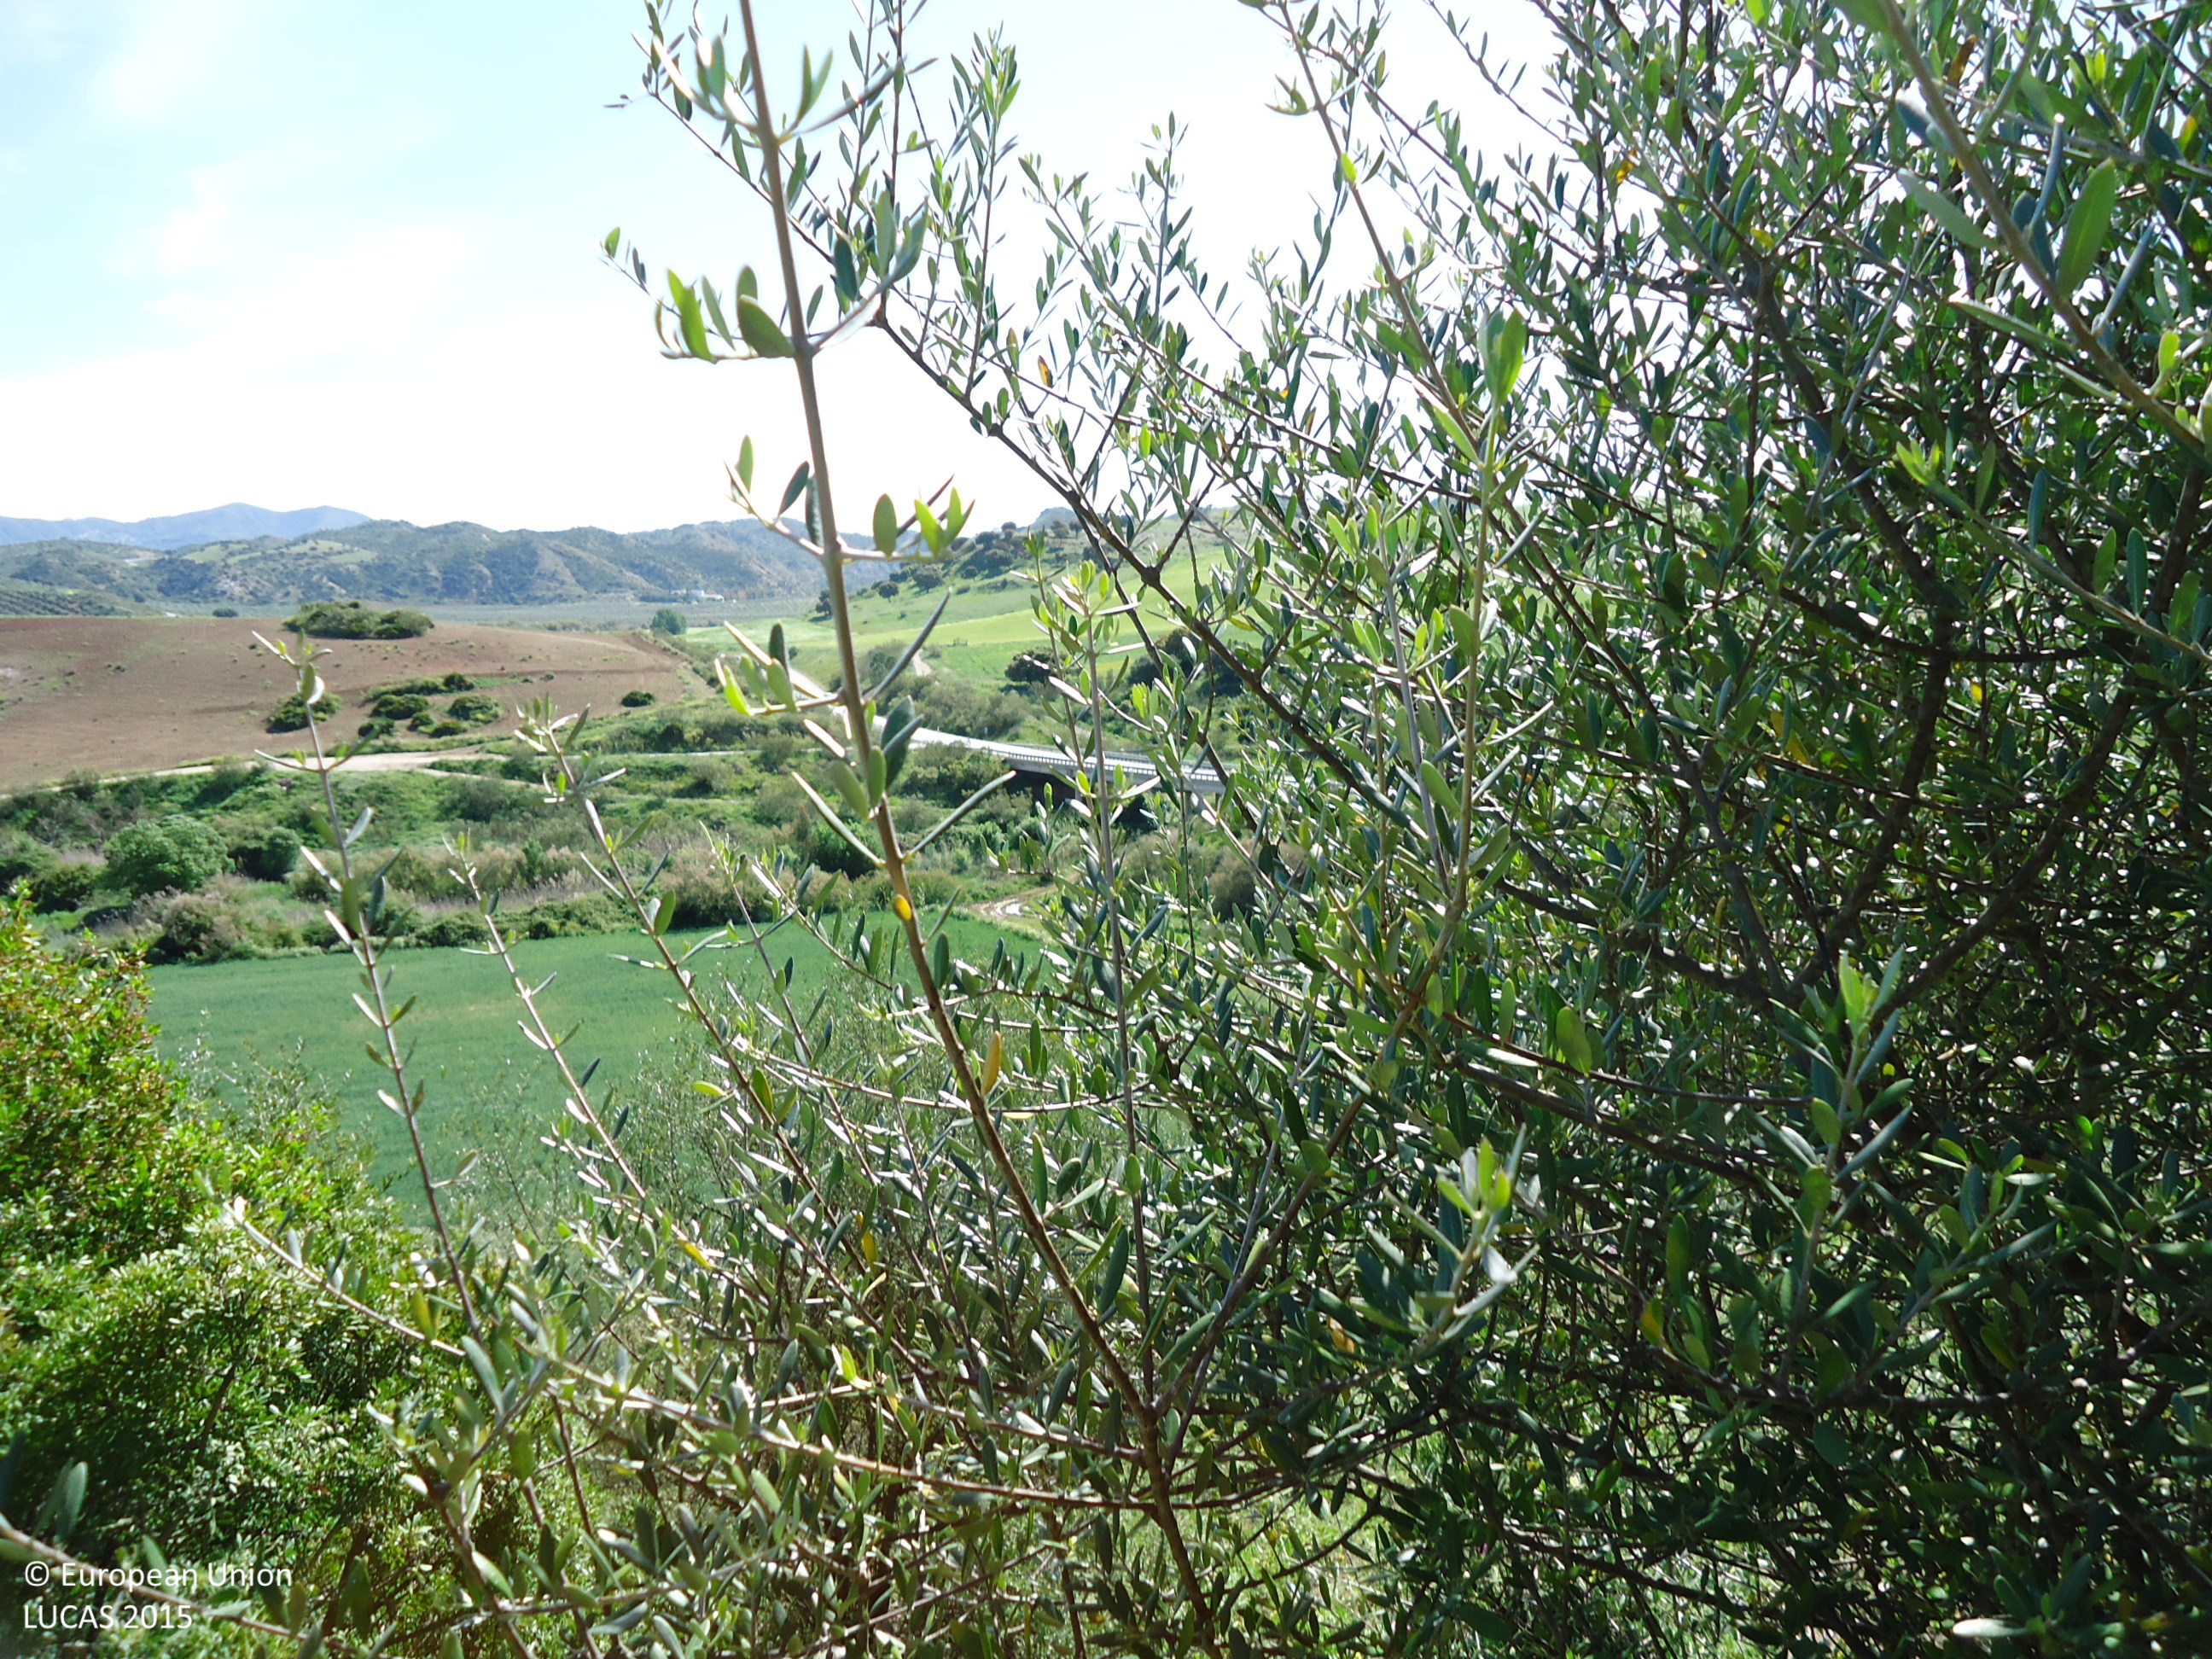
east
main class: Shrubland
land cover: Shrubland with sparse tree cover
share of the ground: 50 - 75 %
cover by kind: shrubs 70 %, herbaceous plants 25 %, broadleaved forest trees 5 %
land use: Agriculture (excluding fallow land and kitchen gardens)
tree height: > 5 m
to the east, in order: Shrubland with sparse tree cover; Fences; Oats; Fences; Spontaneously vegetated surfaces; Tracks; Fences; Shrubland with sparse tree cover; Rivers and streams; Paved roads, cycling and walking lanes; Grass margins; Spontaneously vegetated surfaces
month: April
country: ES
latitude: 36.9348
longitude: -5.3533
